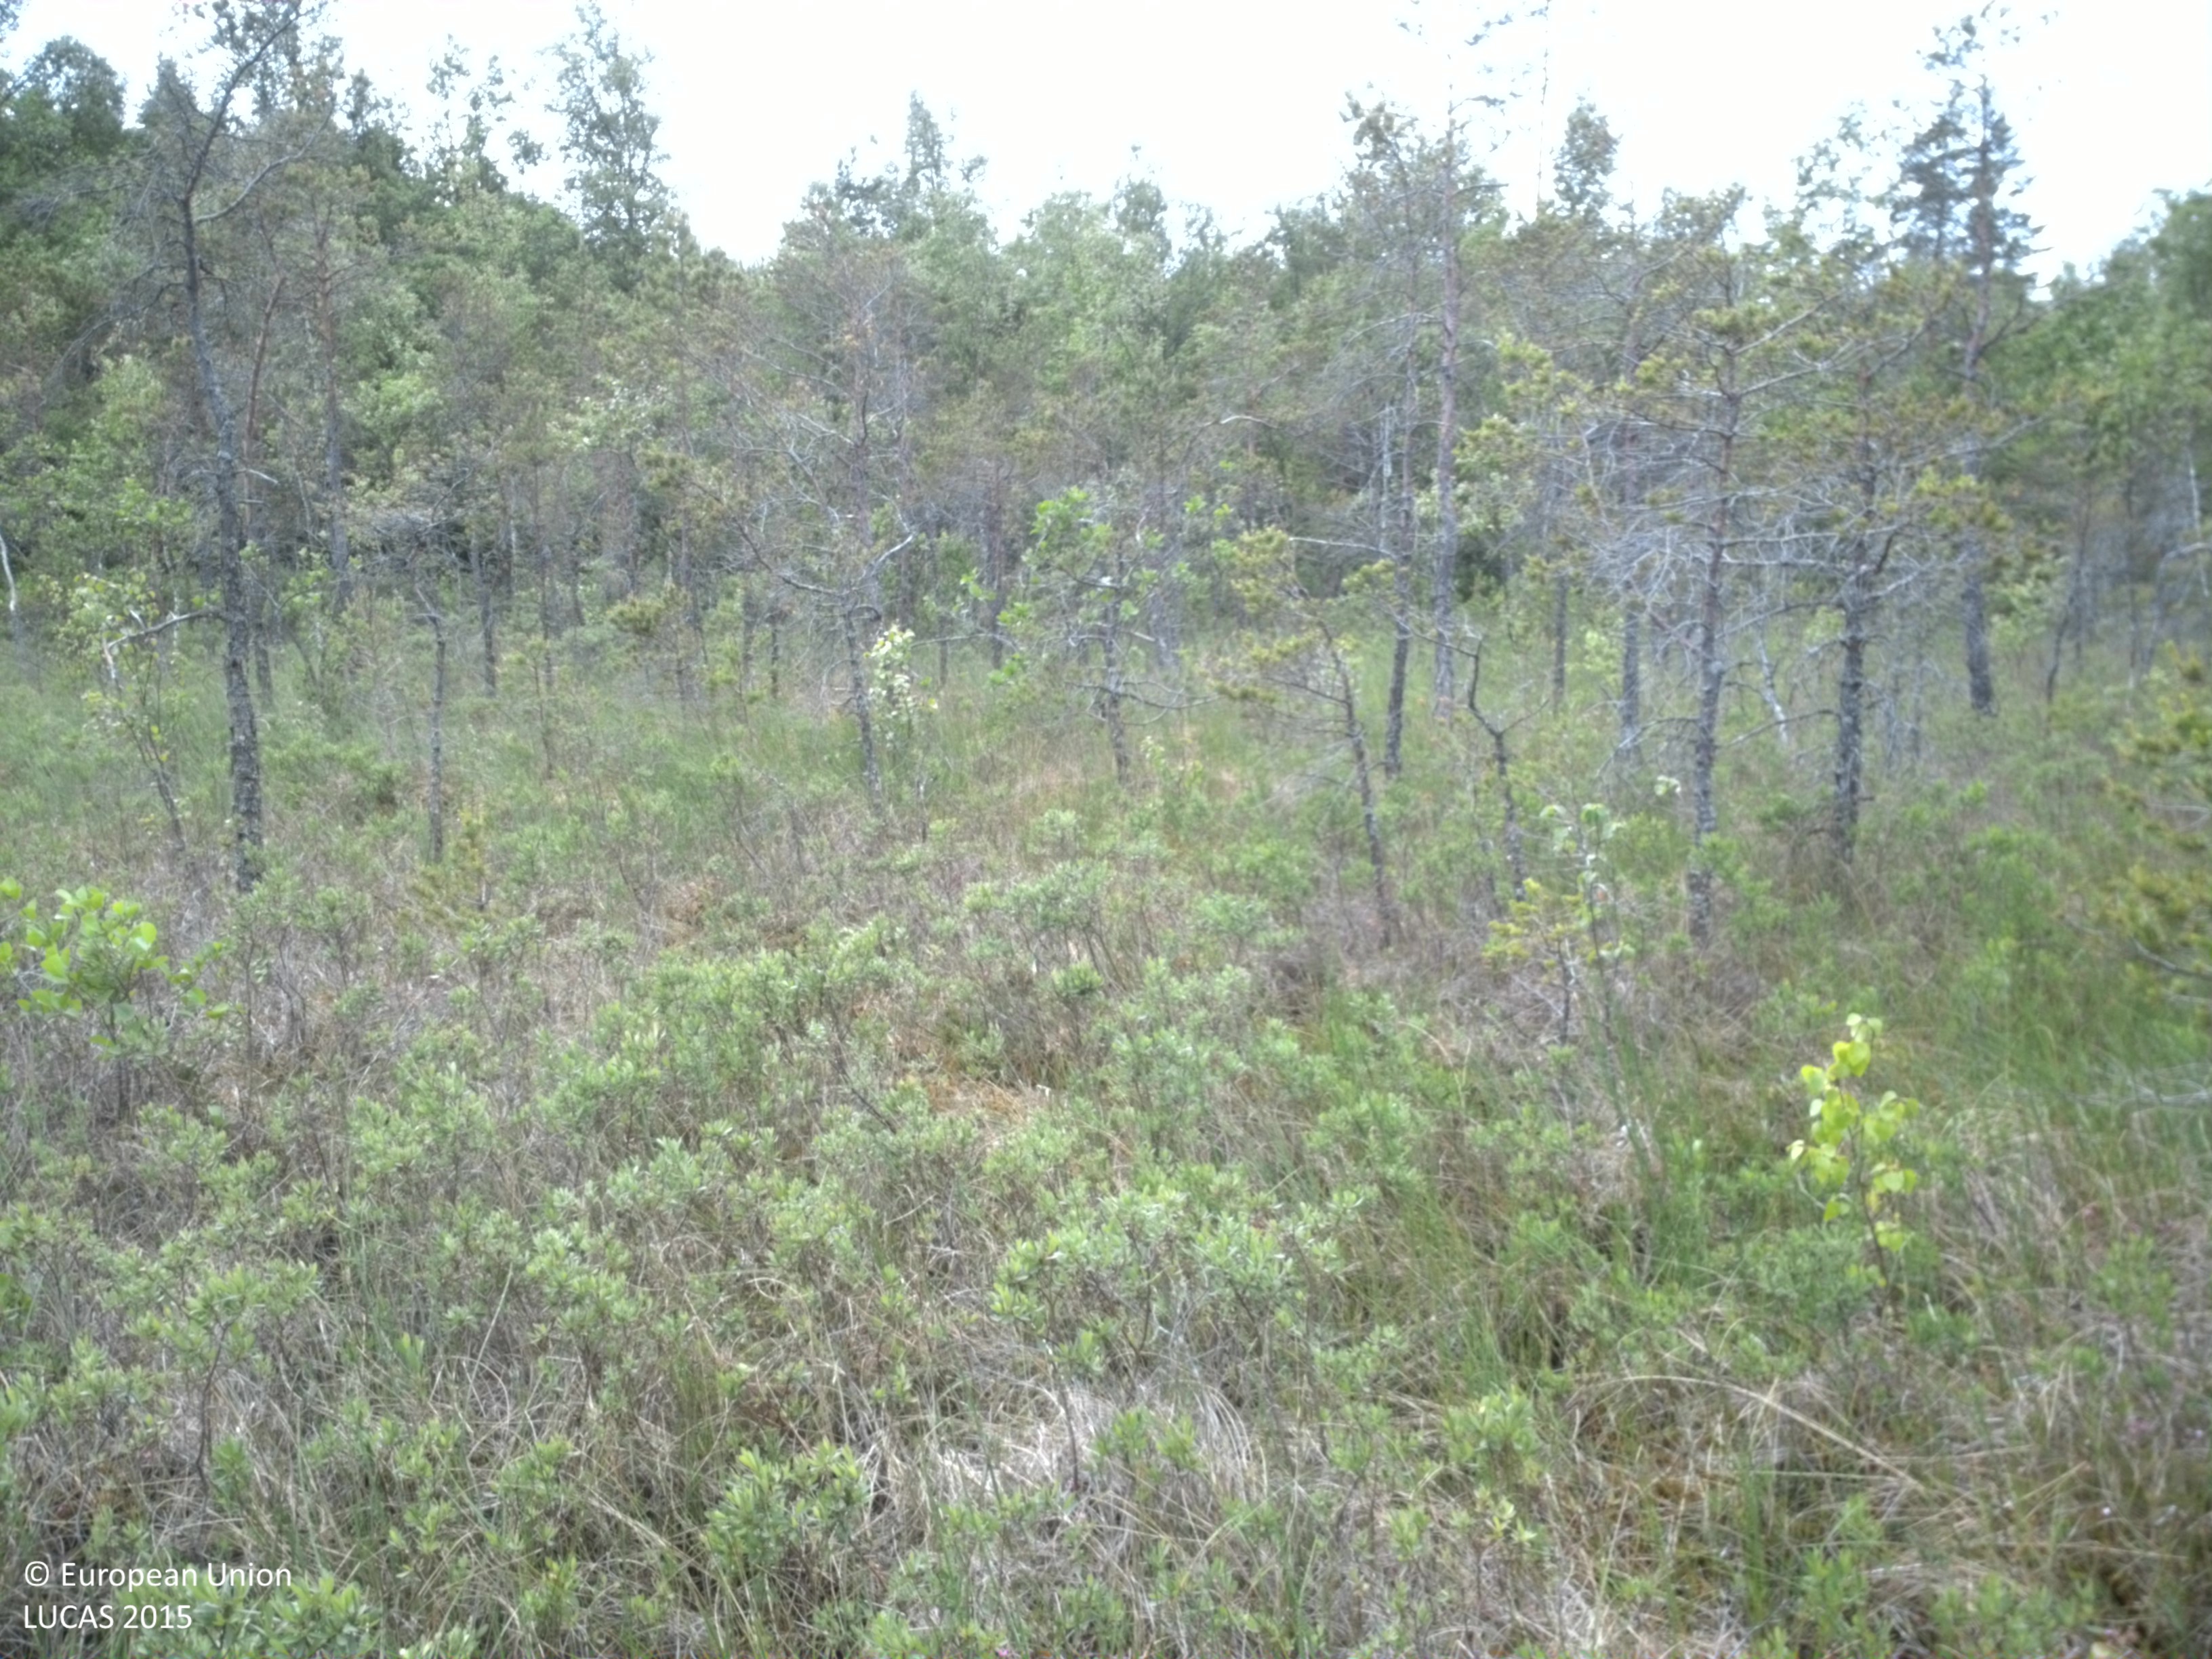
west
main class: Woodland
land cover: Pine dominated coniferous woodland
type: boreal forest
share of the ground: 10 - 25 %
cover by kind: lichens and mosses 50 %, herbaceous plants 35 %, coniferous forest trees 15 %
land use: Semi-natural and natural areas not in use
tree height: < 5 m
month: June
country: SE
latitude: 58.5264
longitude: 16.2288
